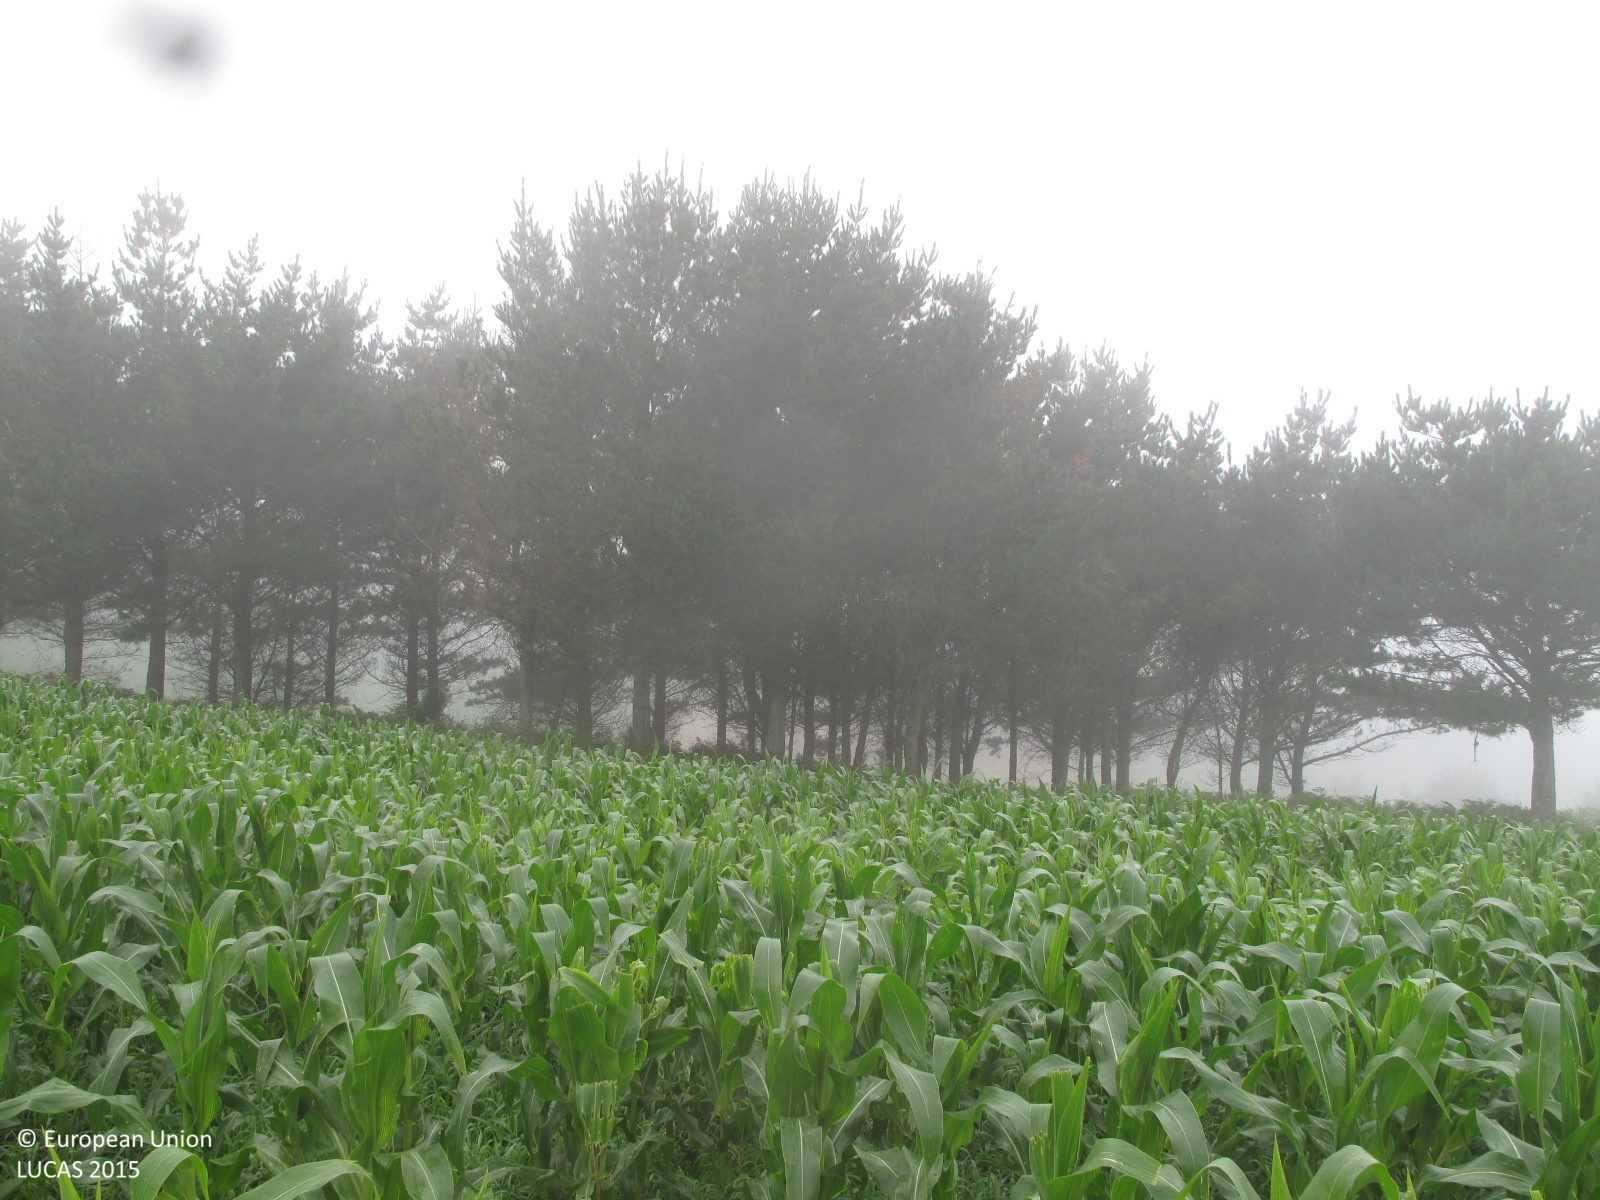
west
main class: Cropland
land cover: Maize
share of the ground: 50 - 75 %
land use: Agriculture (excluding fallow land and kitchen gardens)
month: July
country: ES
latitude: 43.0417
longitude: -9.2675
